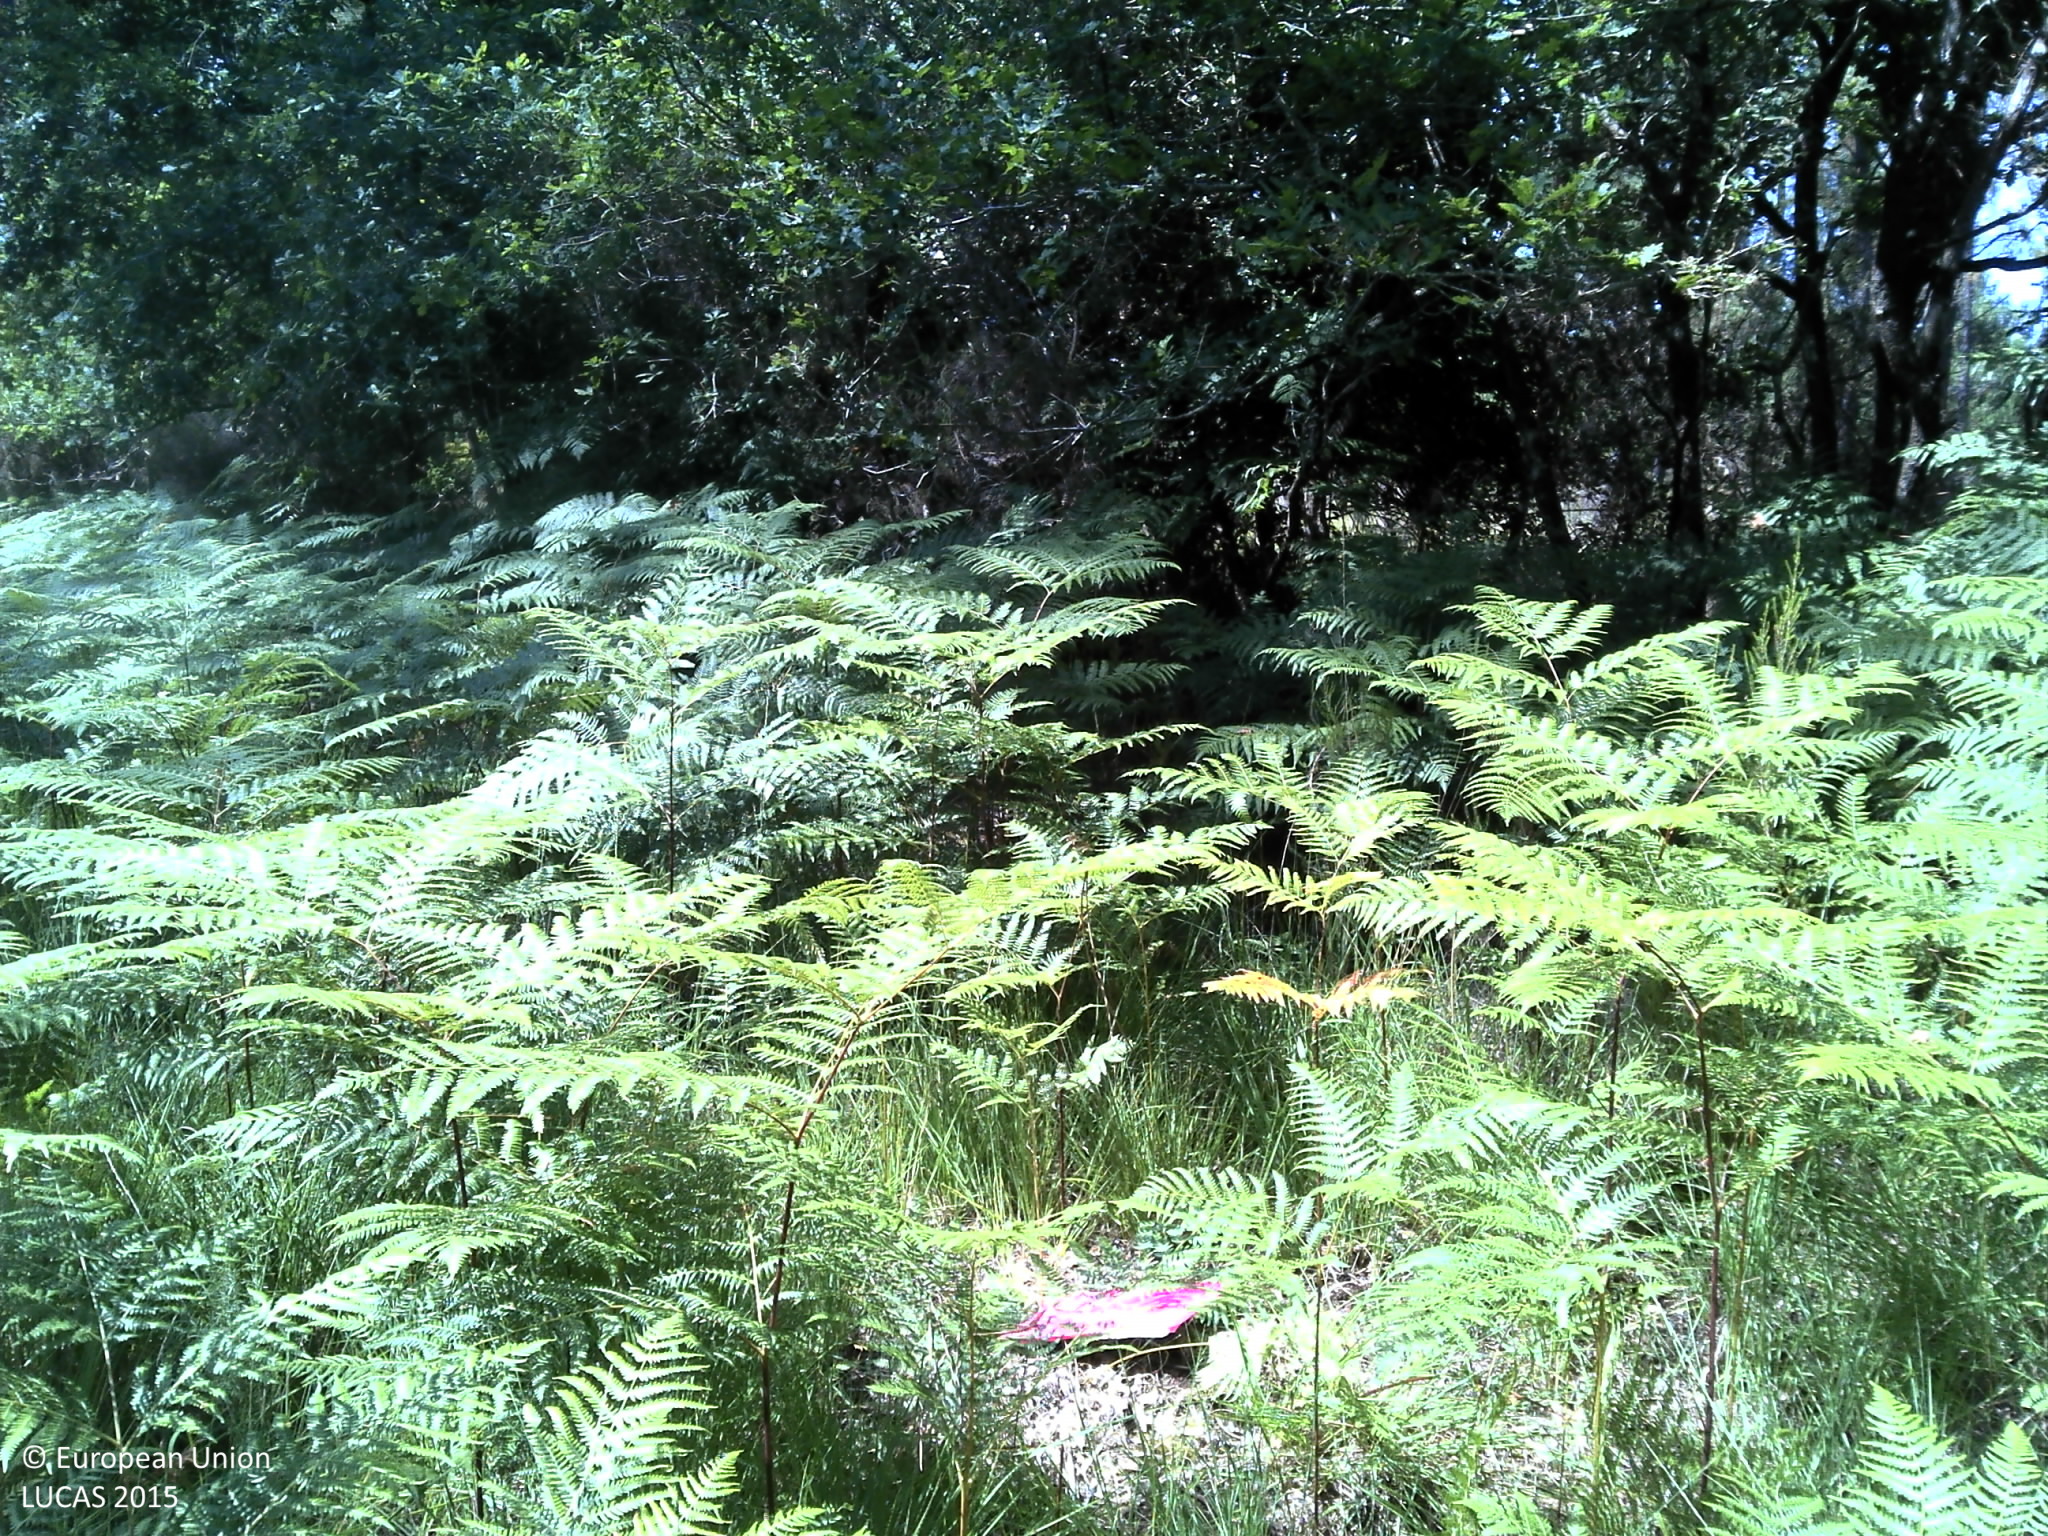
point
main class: Woodland
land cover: Pine dominated coniferous woodland
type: coniferous forest of the mediterranean region
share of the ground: > 75 %
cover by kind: shrubs 45 %, coniferous forest trees 40 %, herbaceous plants 10 %, broadleaved forest trees 5 %
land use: Forestry
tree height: > 5 m
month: August
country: FR
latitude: 45.1788
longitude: -1.0327
